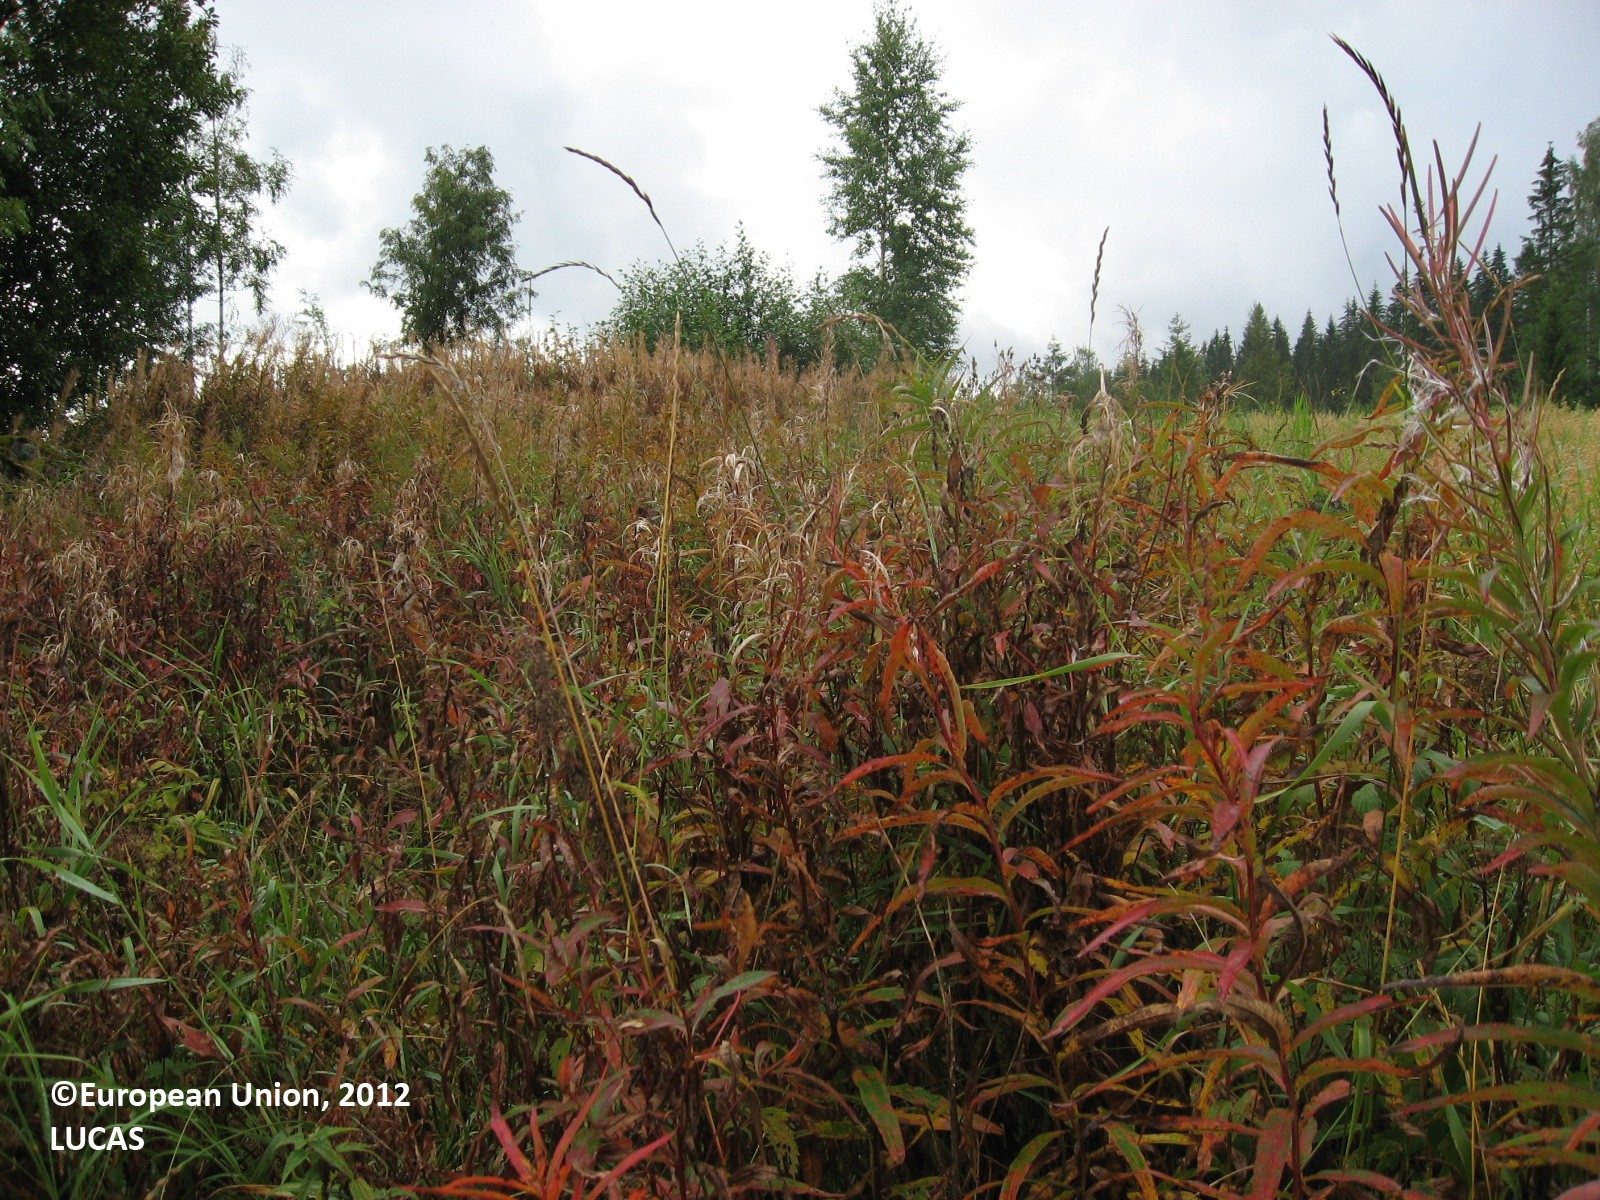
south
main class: Cropland
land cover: Oats
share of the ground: > 75 %
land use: Agriculture (excluding fallow land and kitchen gardens)
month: September
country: FI
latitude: 60.9206
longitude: 25.3013
